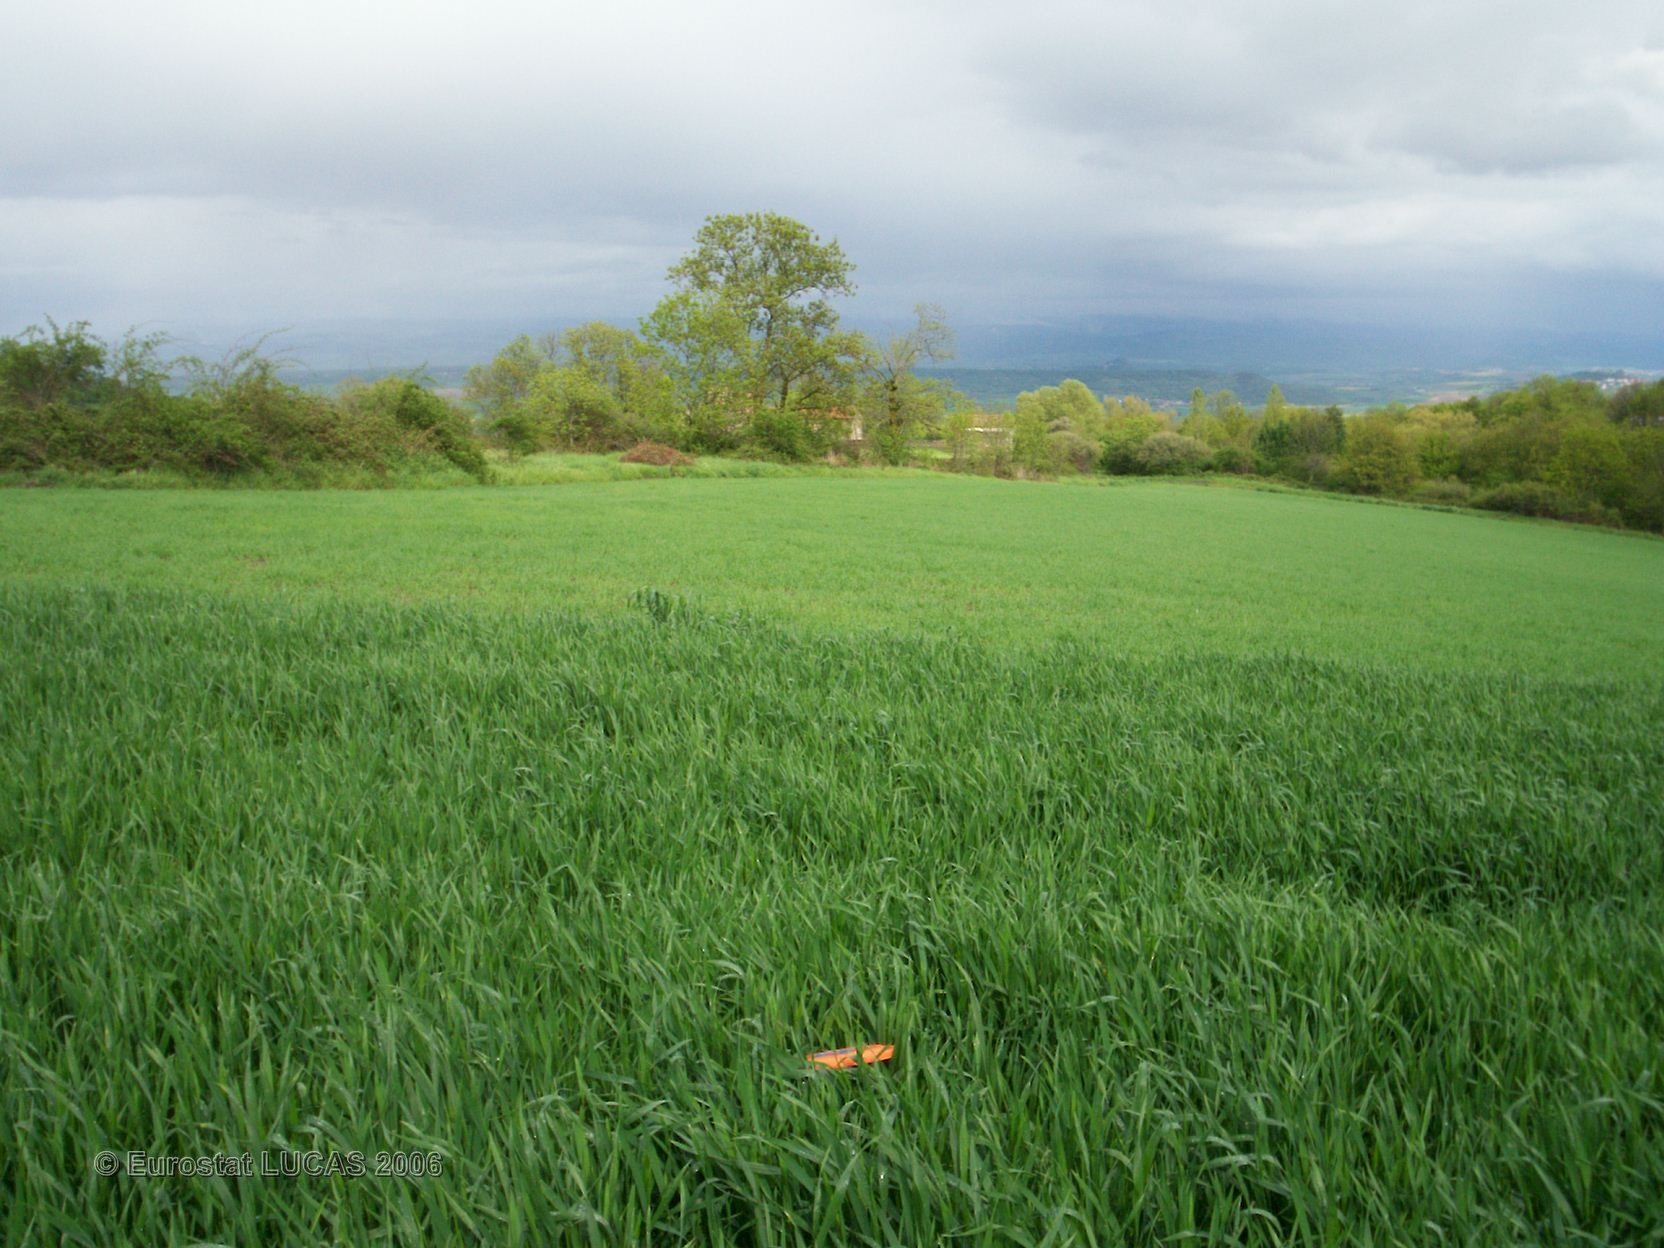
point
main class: Cropland
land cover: Common wheat
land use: Agriculture (excluding fallow land and kitchen gardens)
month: May
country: FR
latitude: 45.4974
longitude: 3.1287
